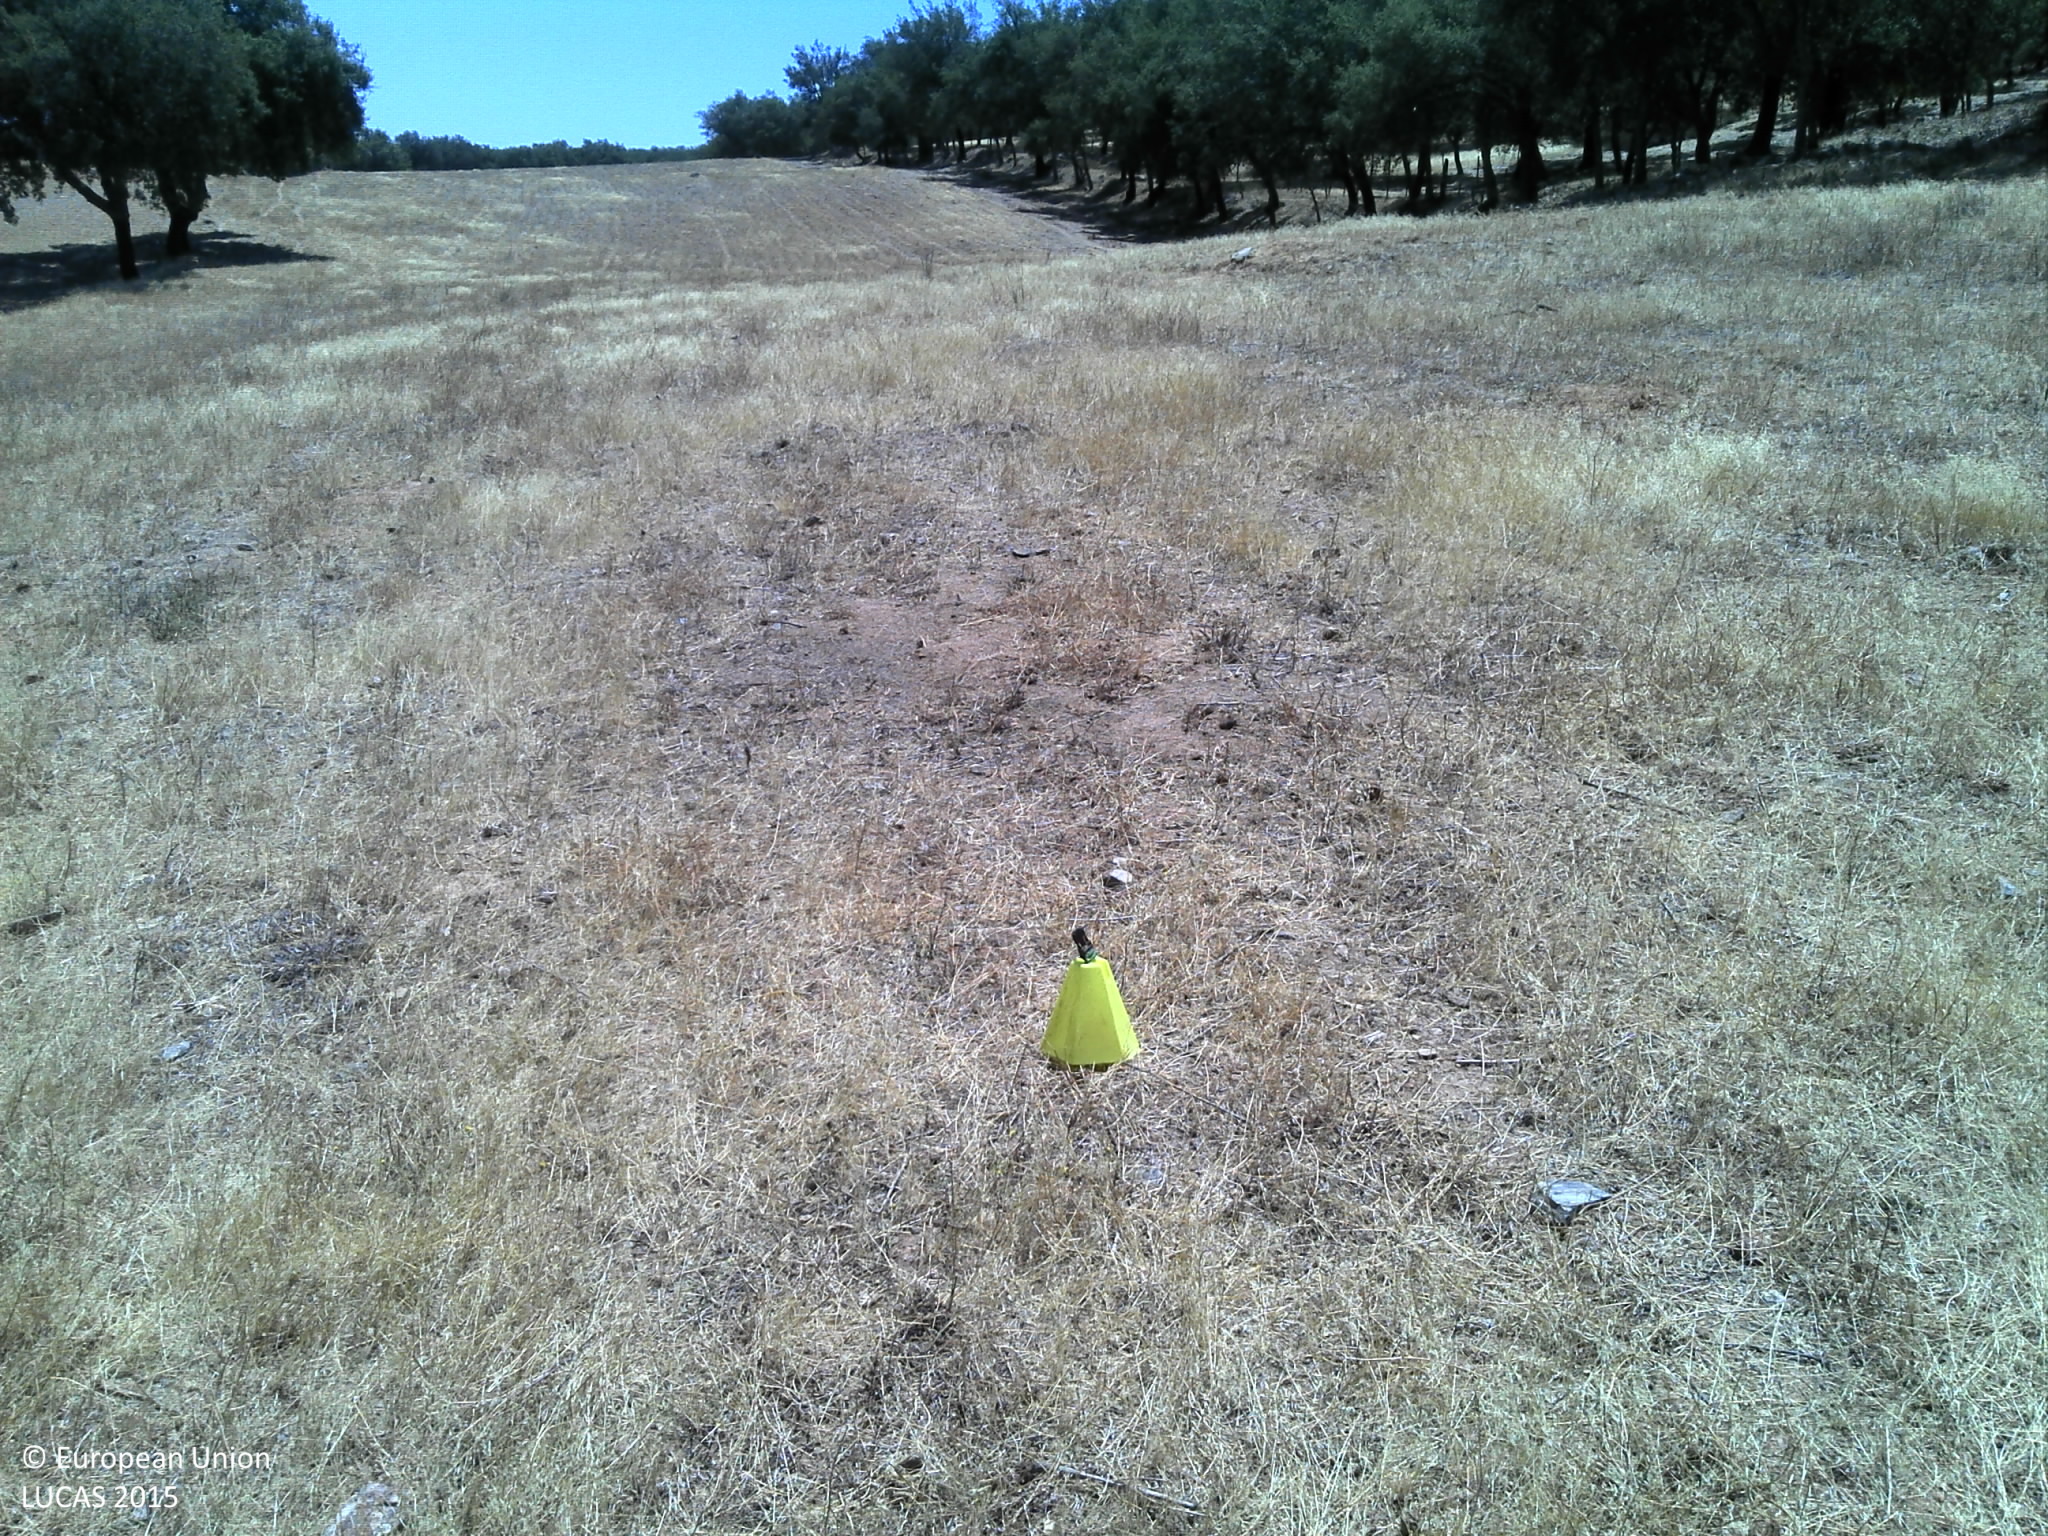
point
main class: Grassland
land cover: Grassland with sparse tree/shrub cover
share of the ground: 10 - 25 %
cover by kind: unconsolidated bare surface 70 %, herbaceous plants 25 %, broadleaved forest trees 5 %
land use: Agriculture (excluding fallow land and kitchen gardens)
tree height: > 5 m
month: July
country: PT
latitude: 38.8660
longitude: -7.4956
